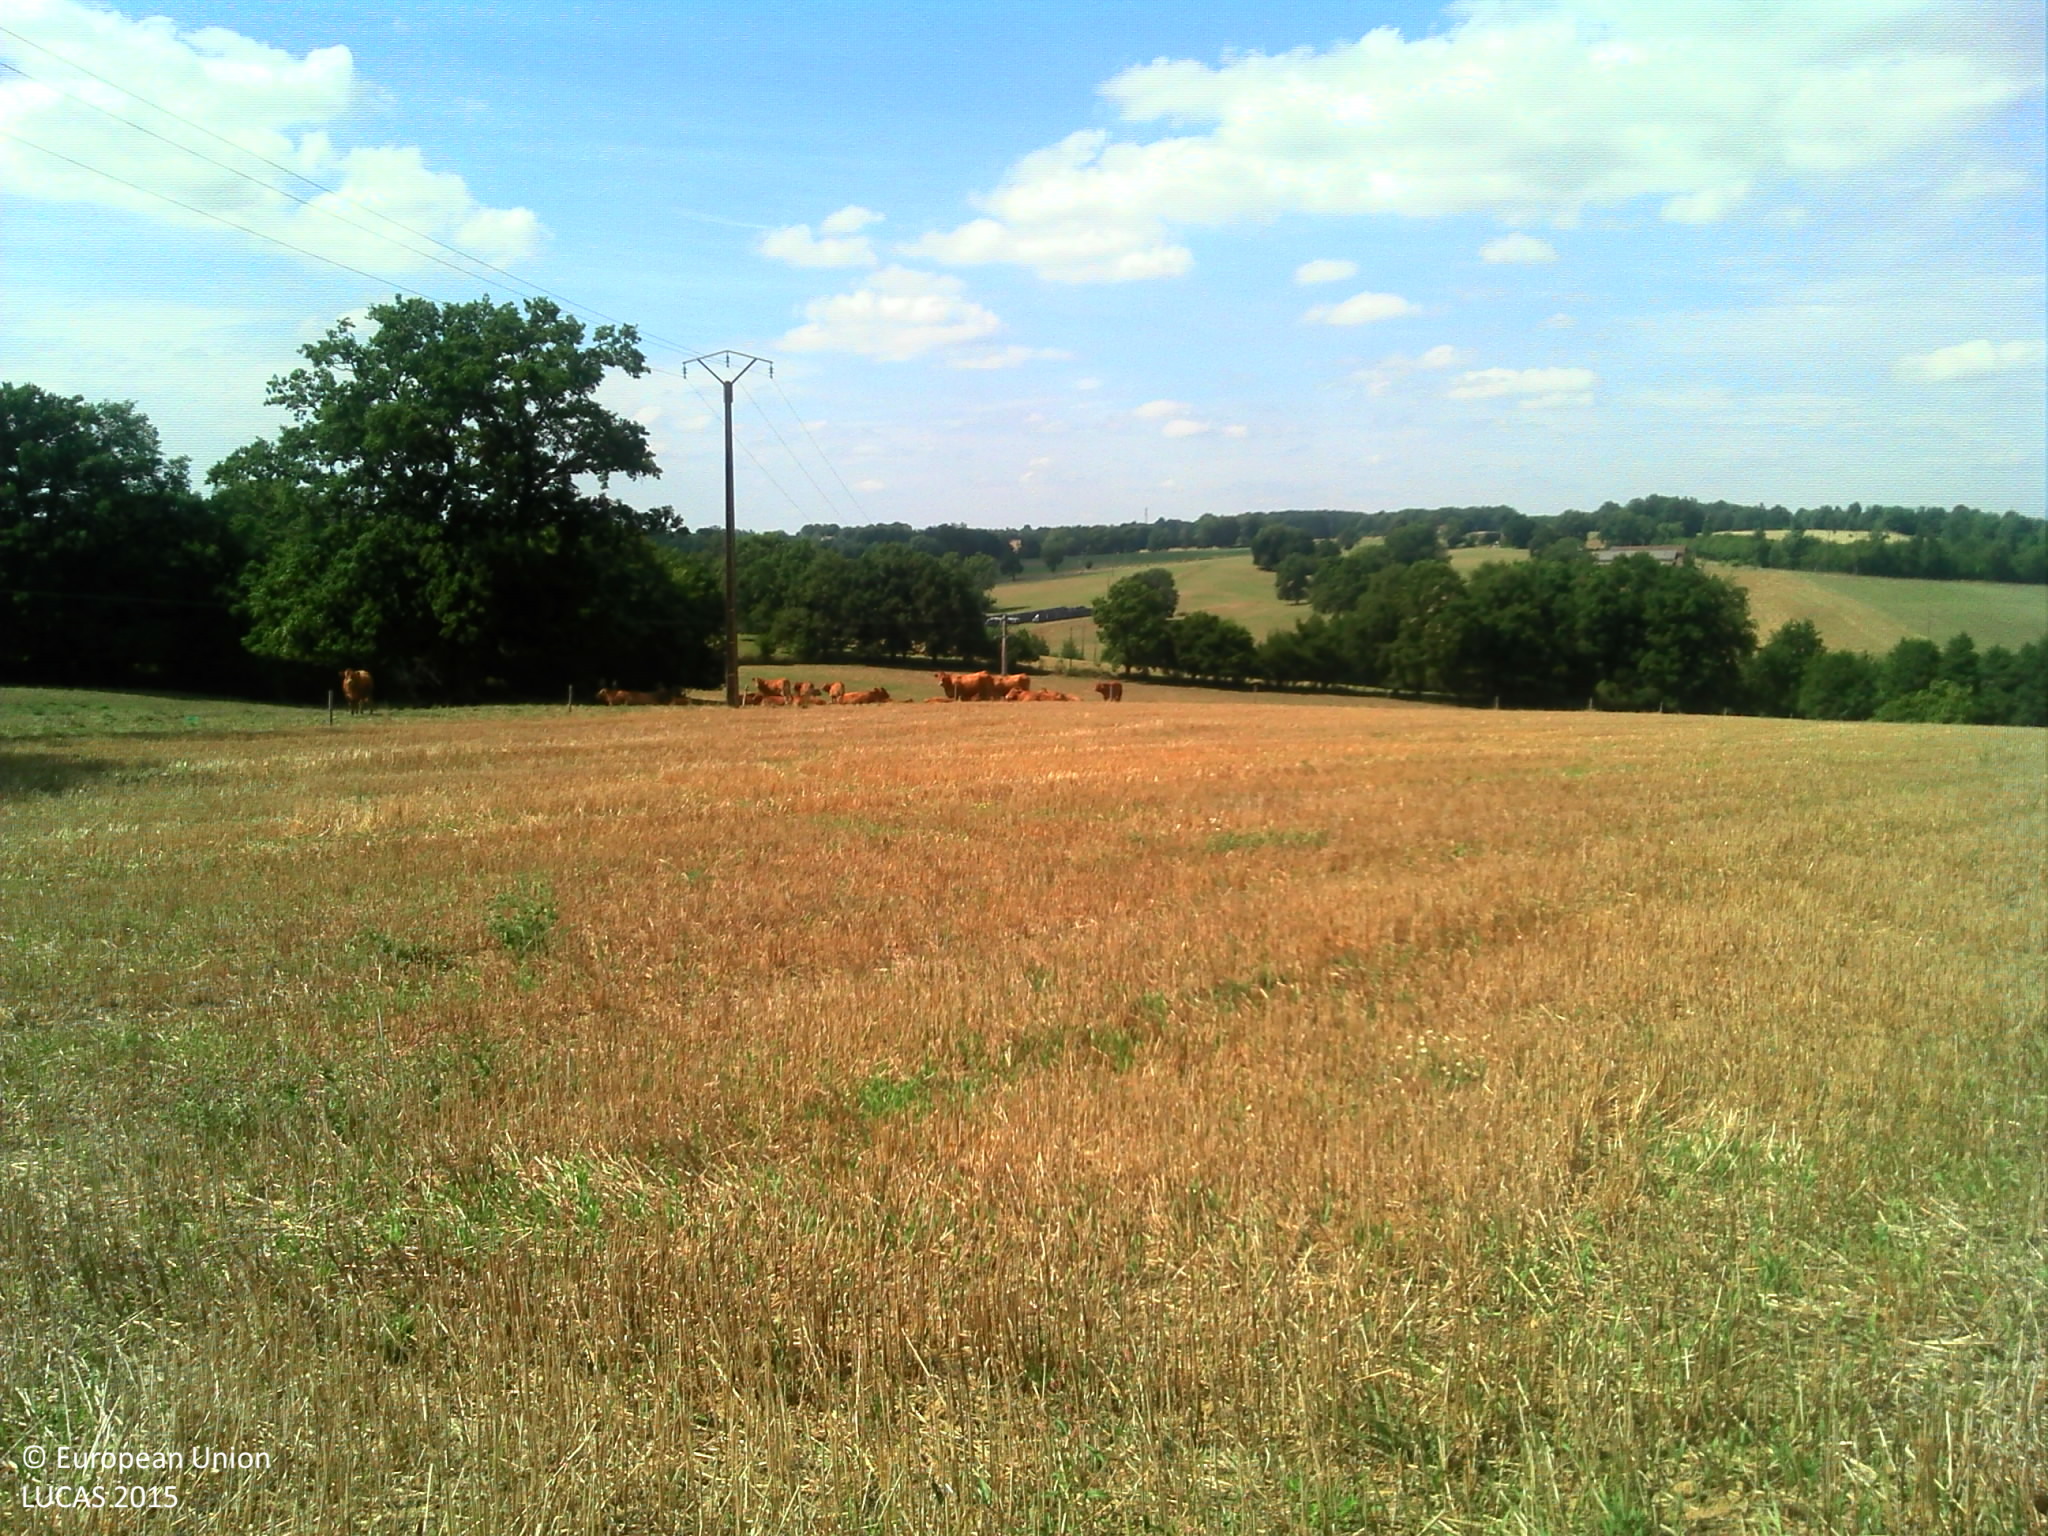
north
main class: Grassland
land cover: Grassland without tree/shrub cover
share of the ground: > 75 %
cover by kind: herbaceous plants 95 %
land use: Agriculture (excluding fallow land and kitchen gardens)
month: August
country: FR
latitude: 45.7039
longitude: 1.2703
